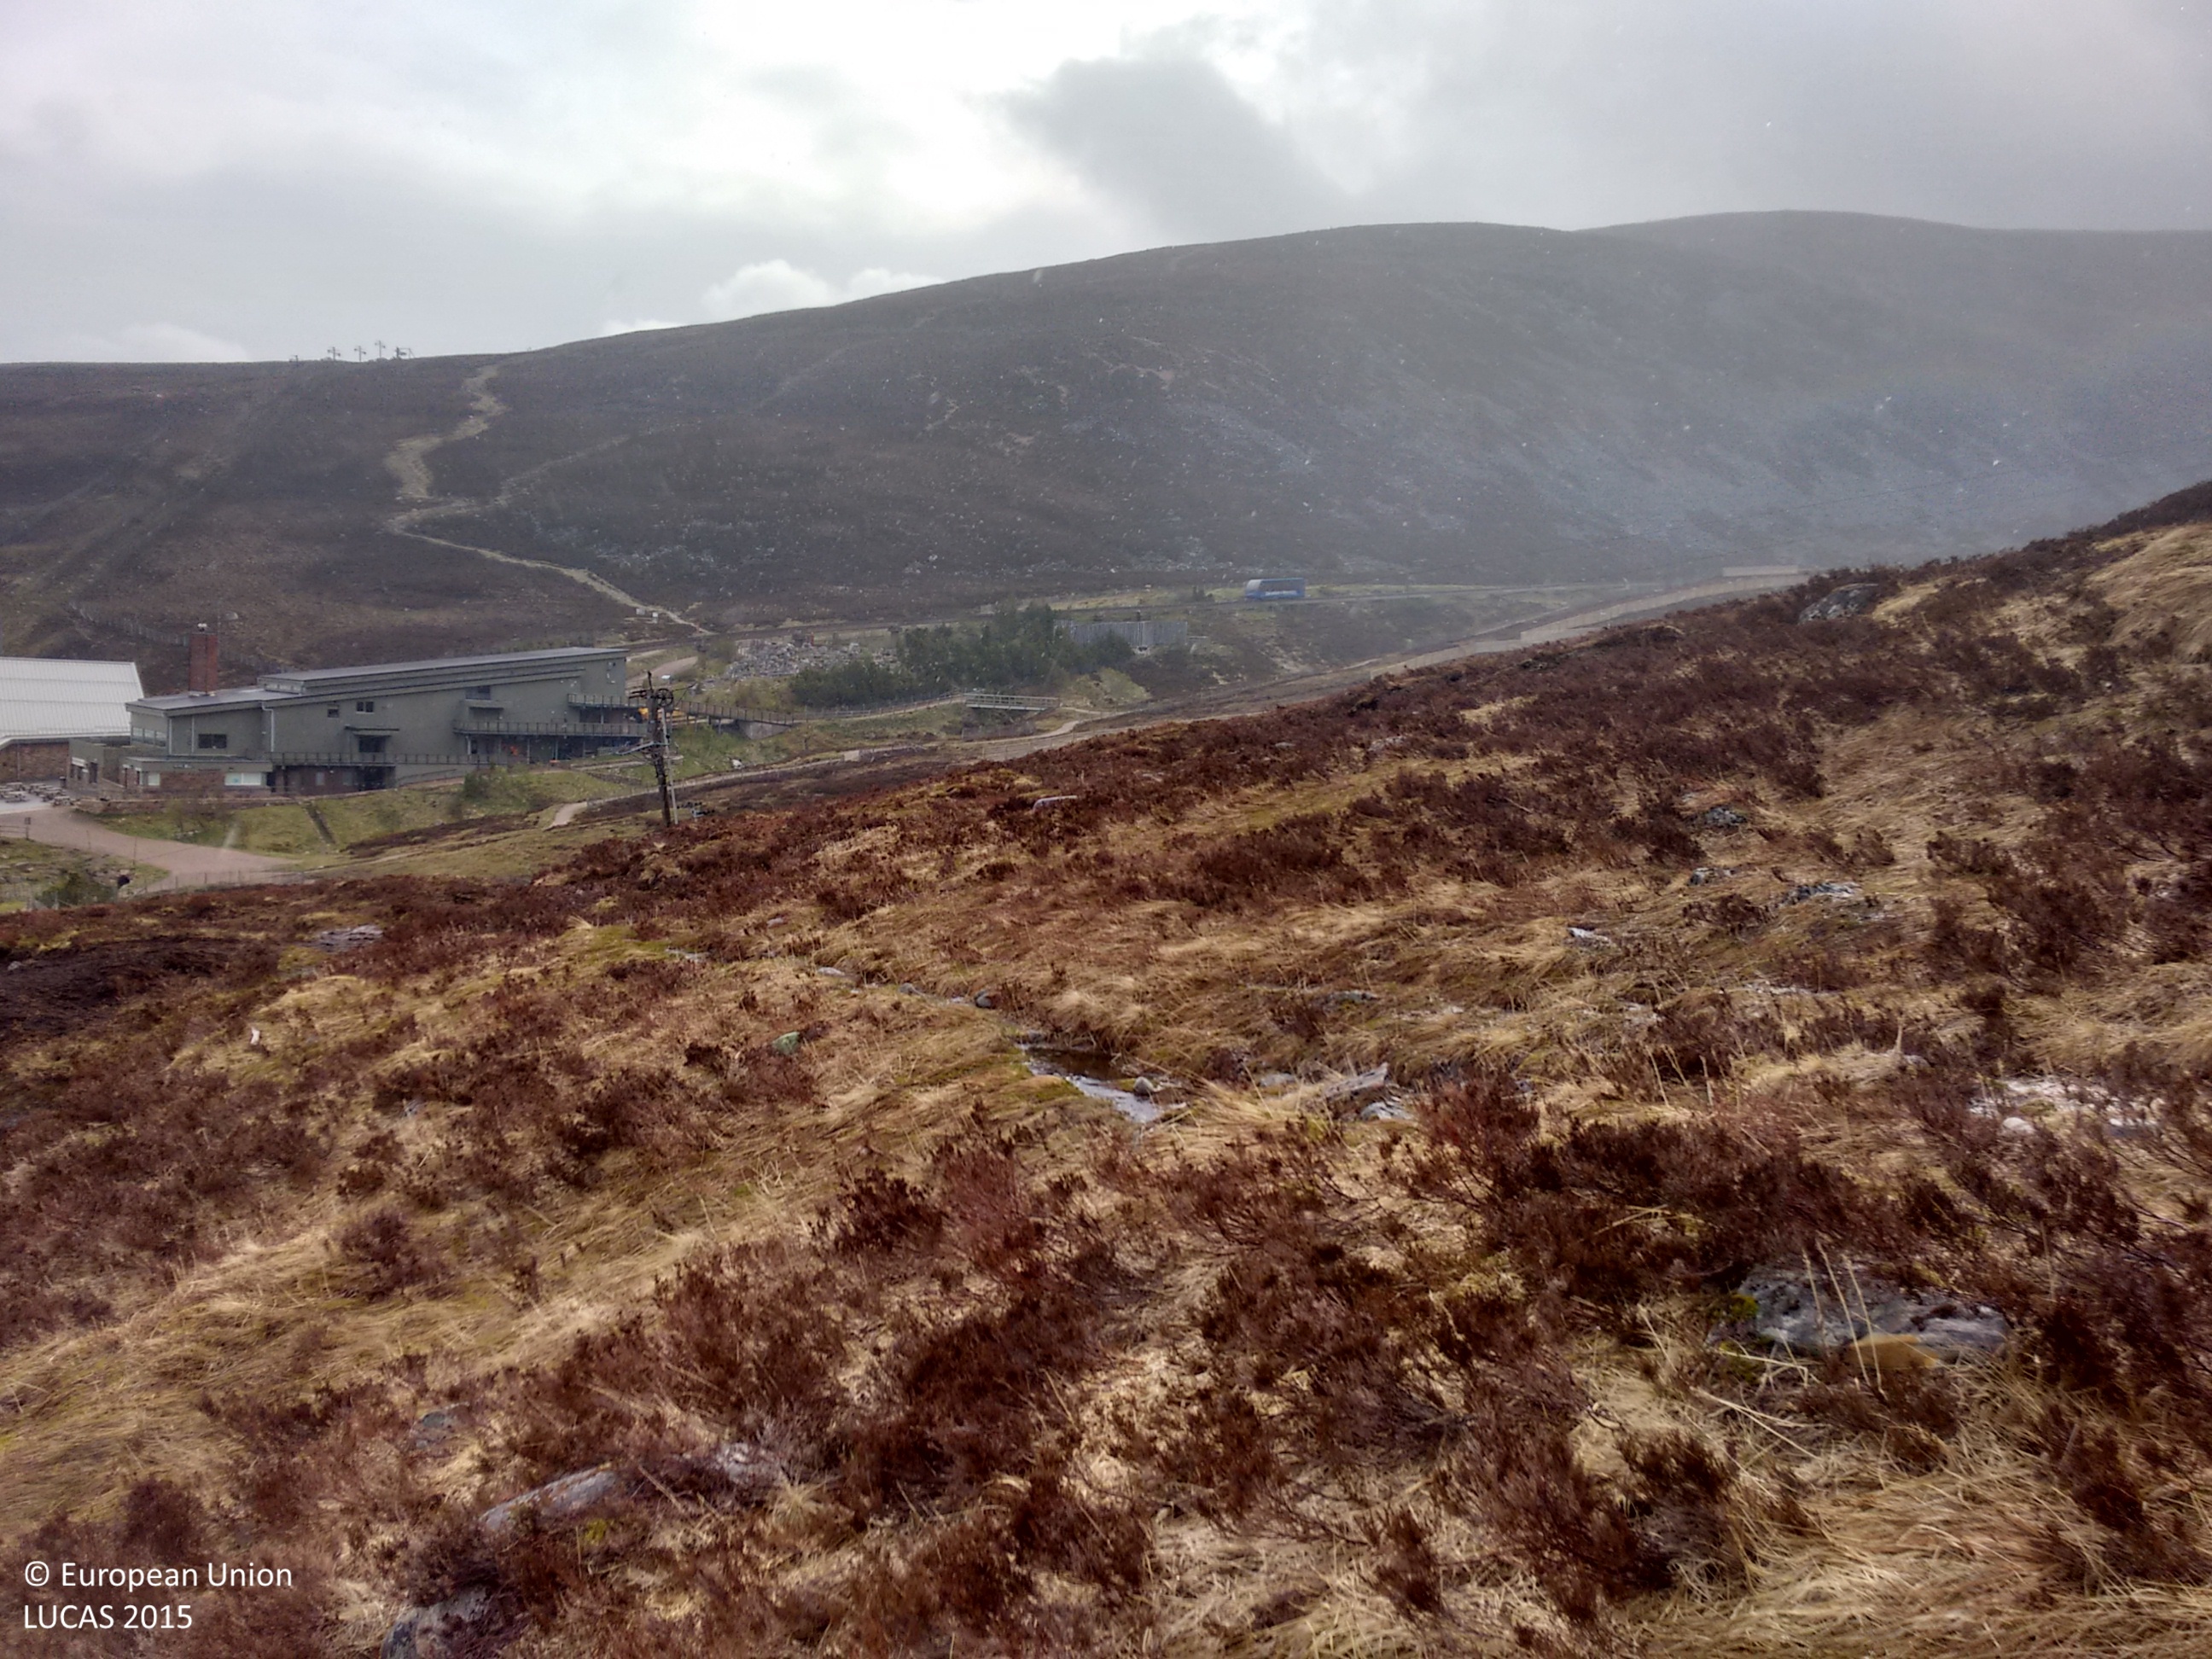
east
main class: Shrubland
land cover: Shrubland without tree cover
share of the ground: > 75 %
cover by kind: shrubs 55 %, herbaceous plants 40 %, unconsolidated bare surface 5 %
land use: Sport
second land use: Amenities, museums, leisure
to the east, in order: Shrubland without tree cover; Fences; Shrubland without tree cover; Electric lines; Fences; Shrubland without tree cover; Ditches and canals; Electric lines; Ponds and wetlands; Shrubland without tree cover; Ponds and wetlands; Shrubland without tree cover; Fences; Shrubland without tree cover; Fences; Shrubland without tree cover; Fences; Shrubland without tree cover
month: June
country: GB
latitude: 57.1323
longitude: -3.6726
